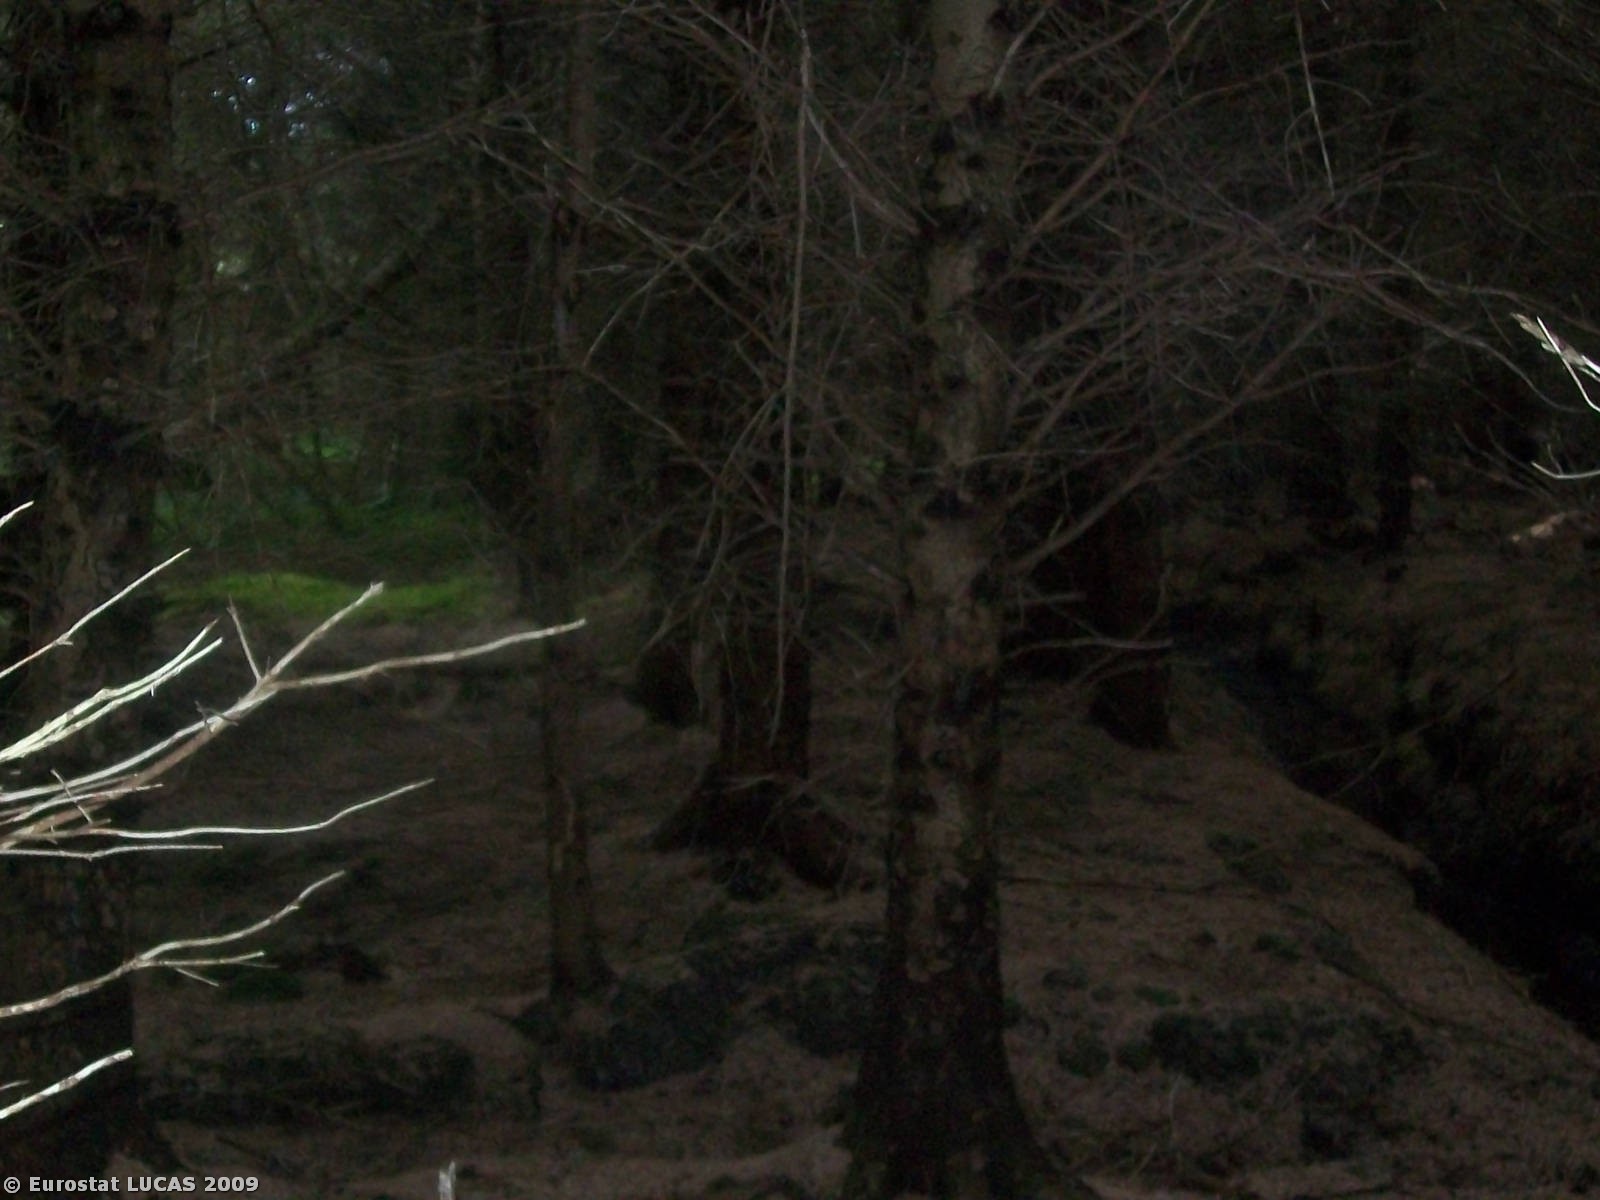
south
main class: Woodland
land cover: Coniferous woodland
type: plantations and self-sown exotic forest
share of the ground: > 75 %
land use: Forestry
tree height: > 5 m
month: July
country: IE
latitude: 54.3753
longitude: -8.5274
